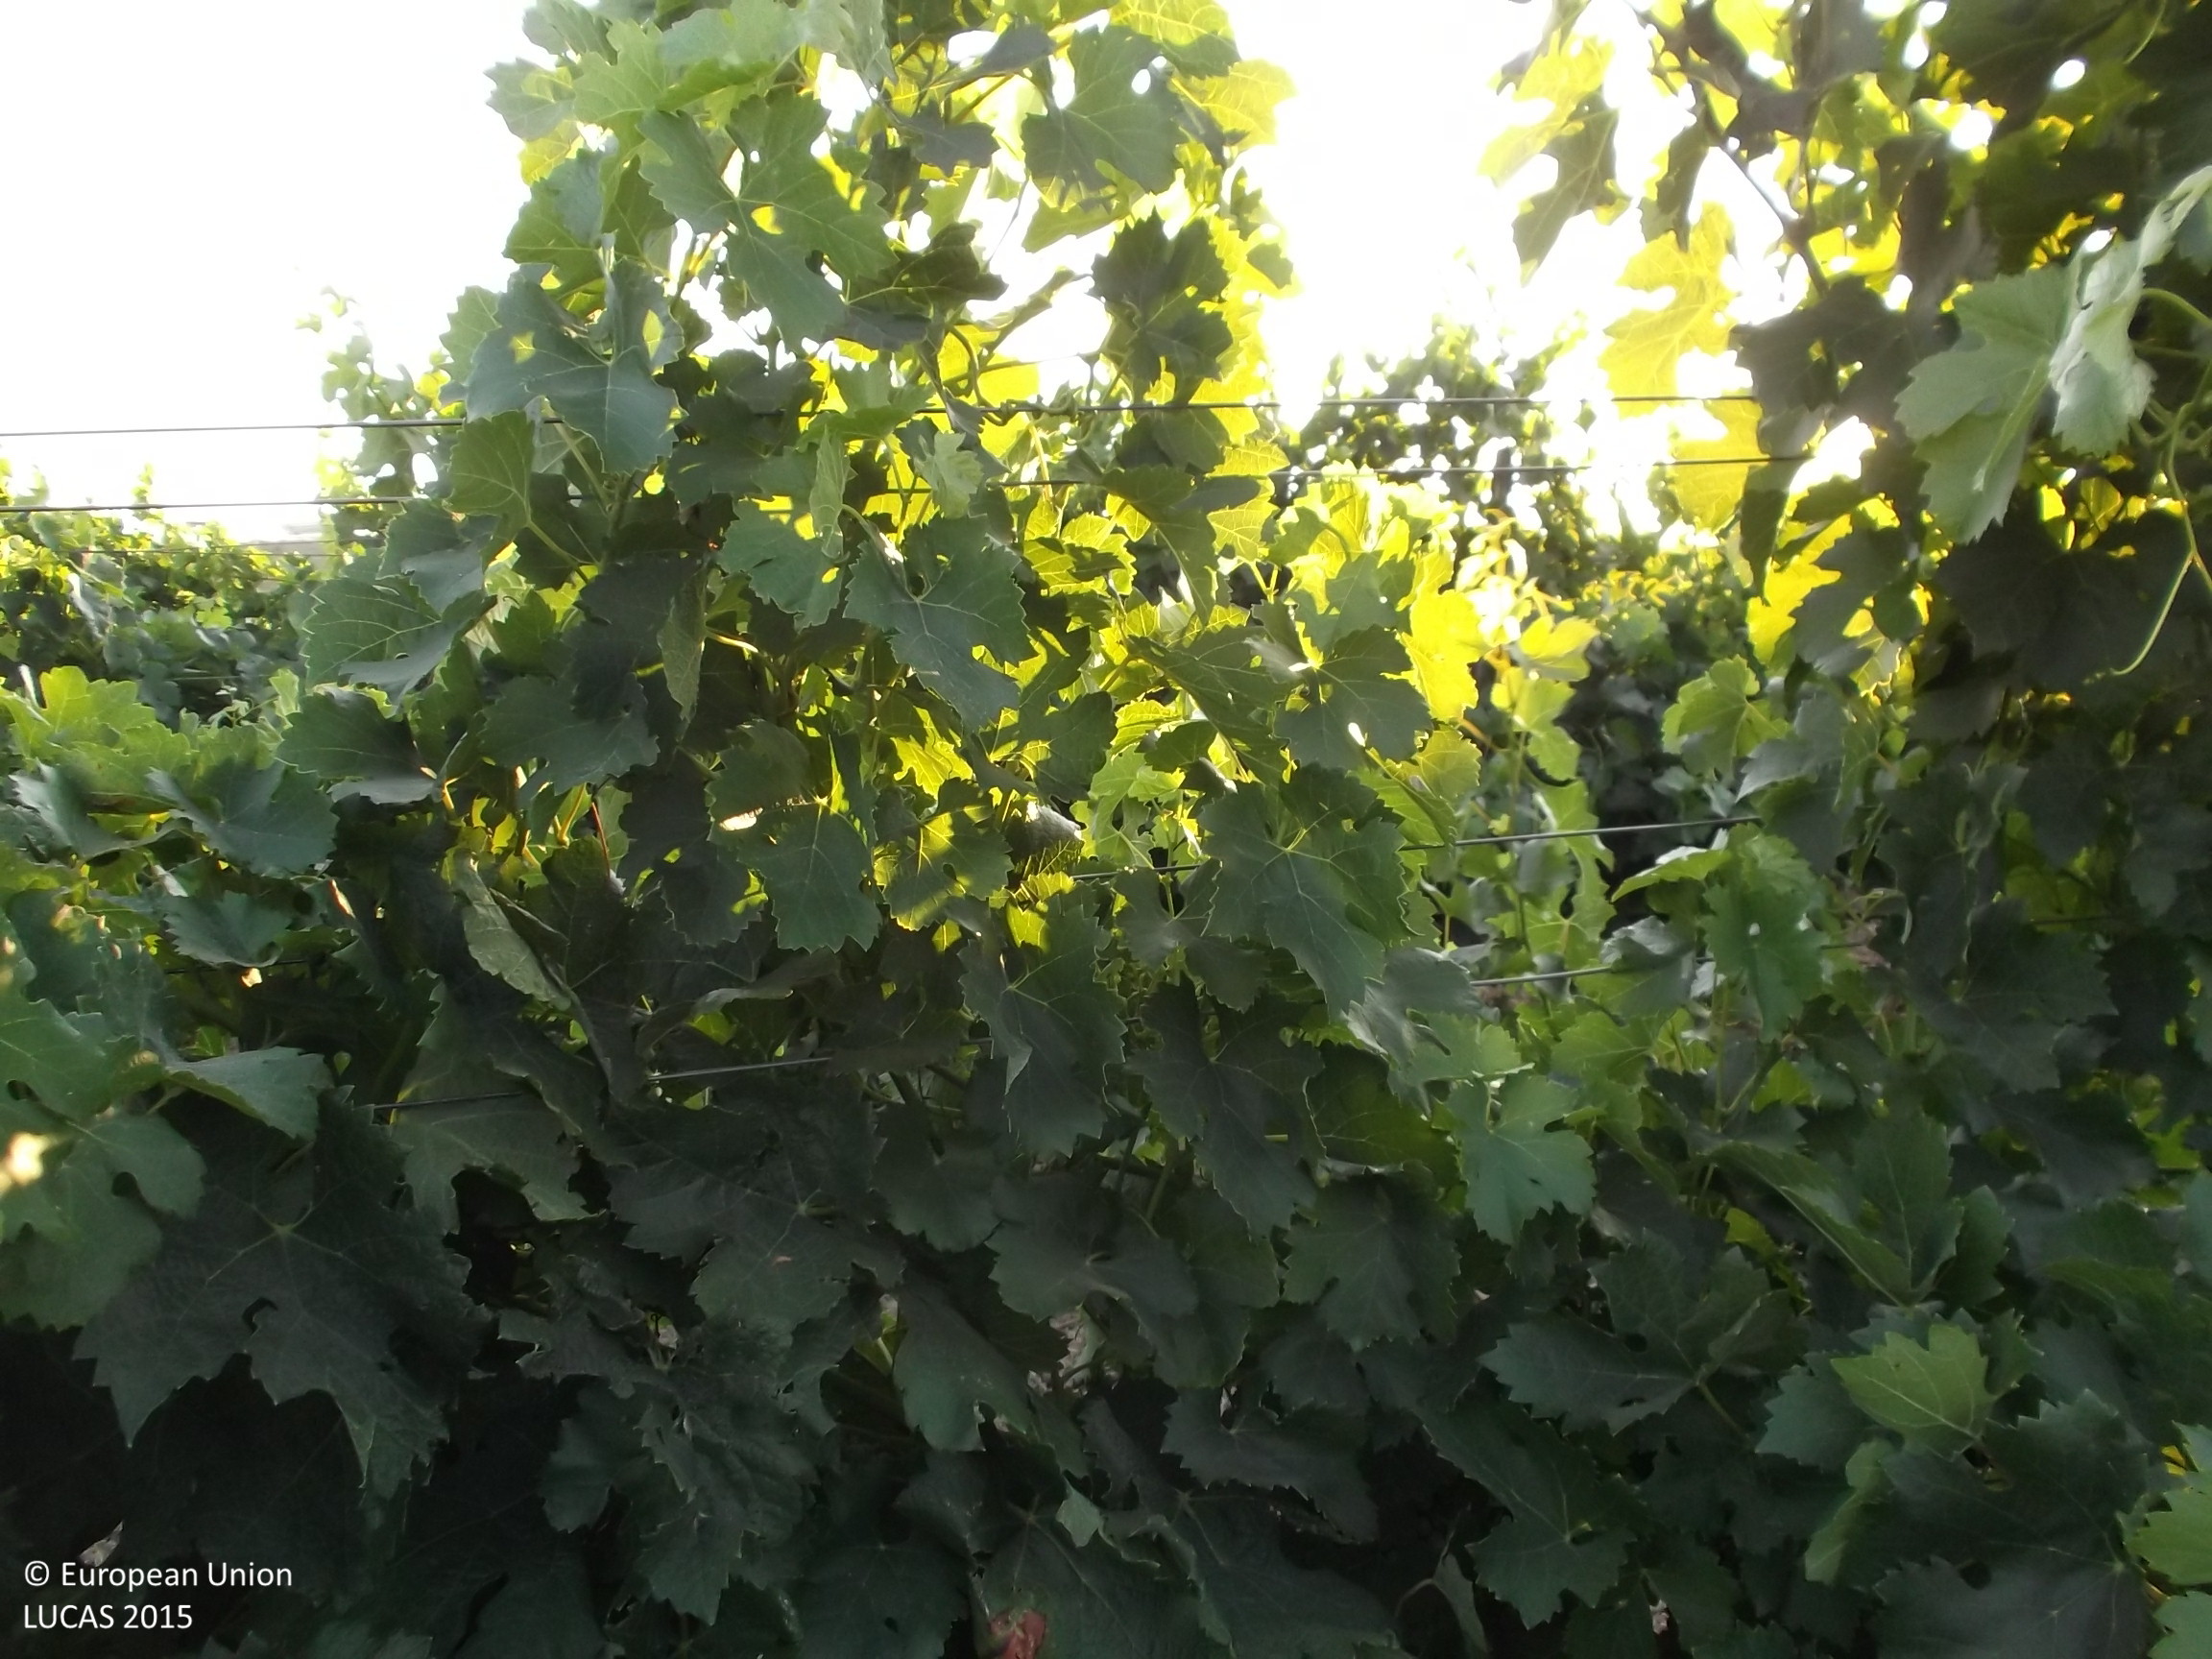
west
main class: Cropland
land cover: Vineyards
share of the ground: 10 - 25 %
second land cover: Other bare soil
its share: > 75 %
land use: Agriculture (excluding fallow land and kitchen gardens)
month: July
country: ES
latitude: 42.4356
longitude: -1.6447
